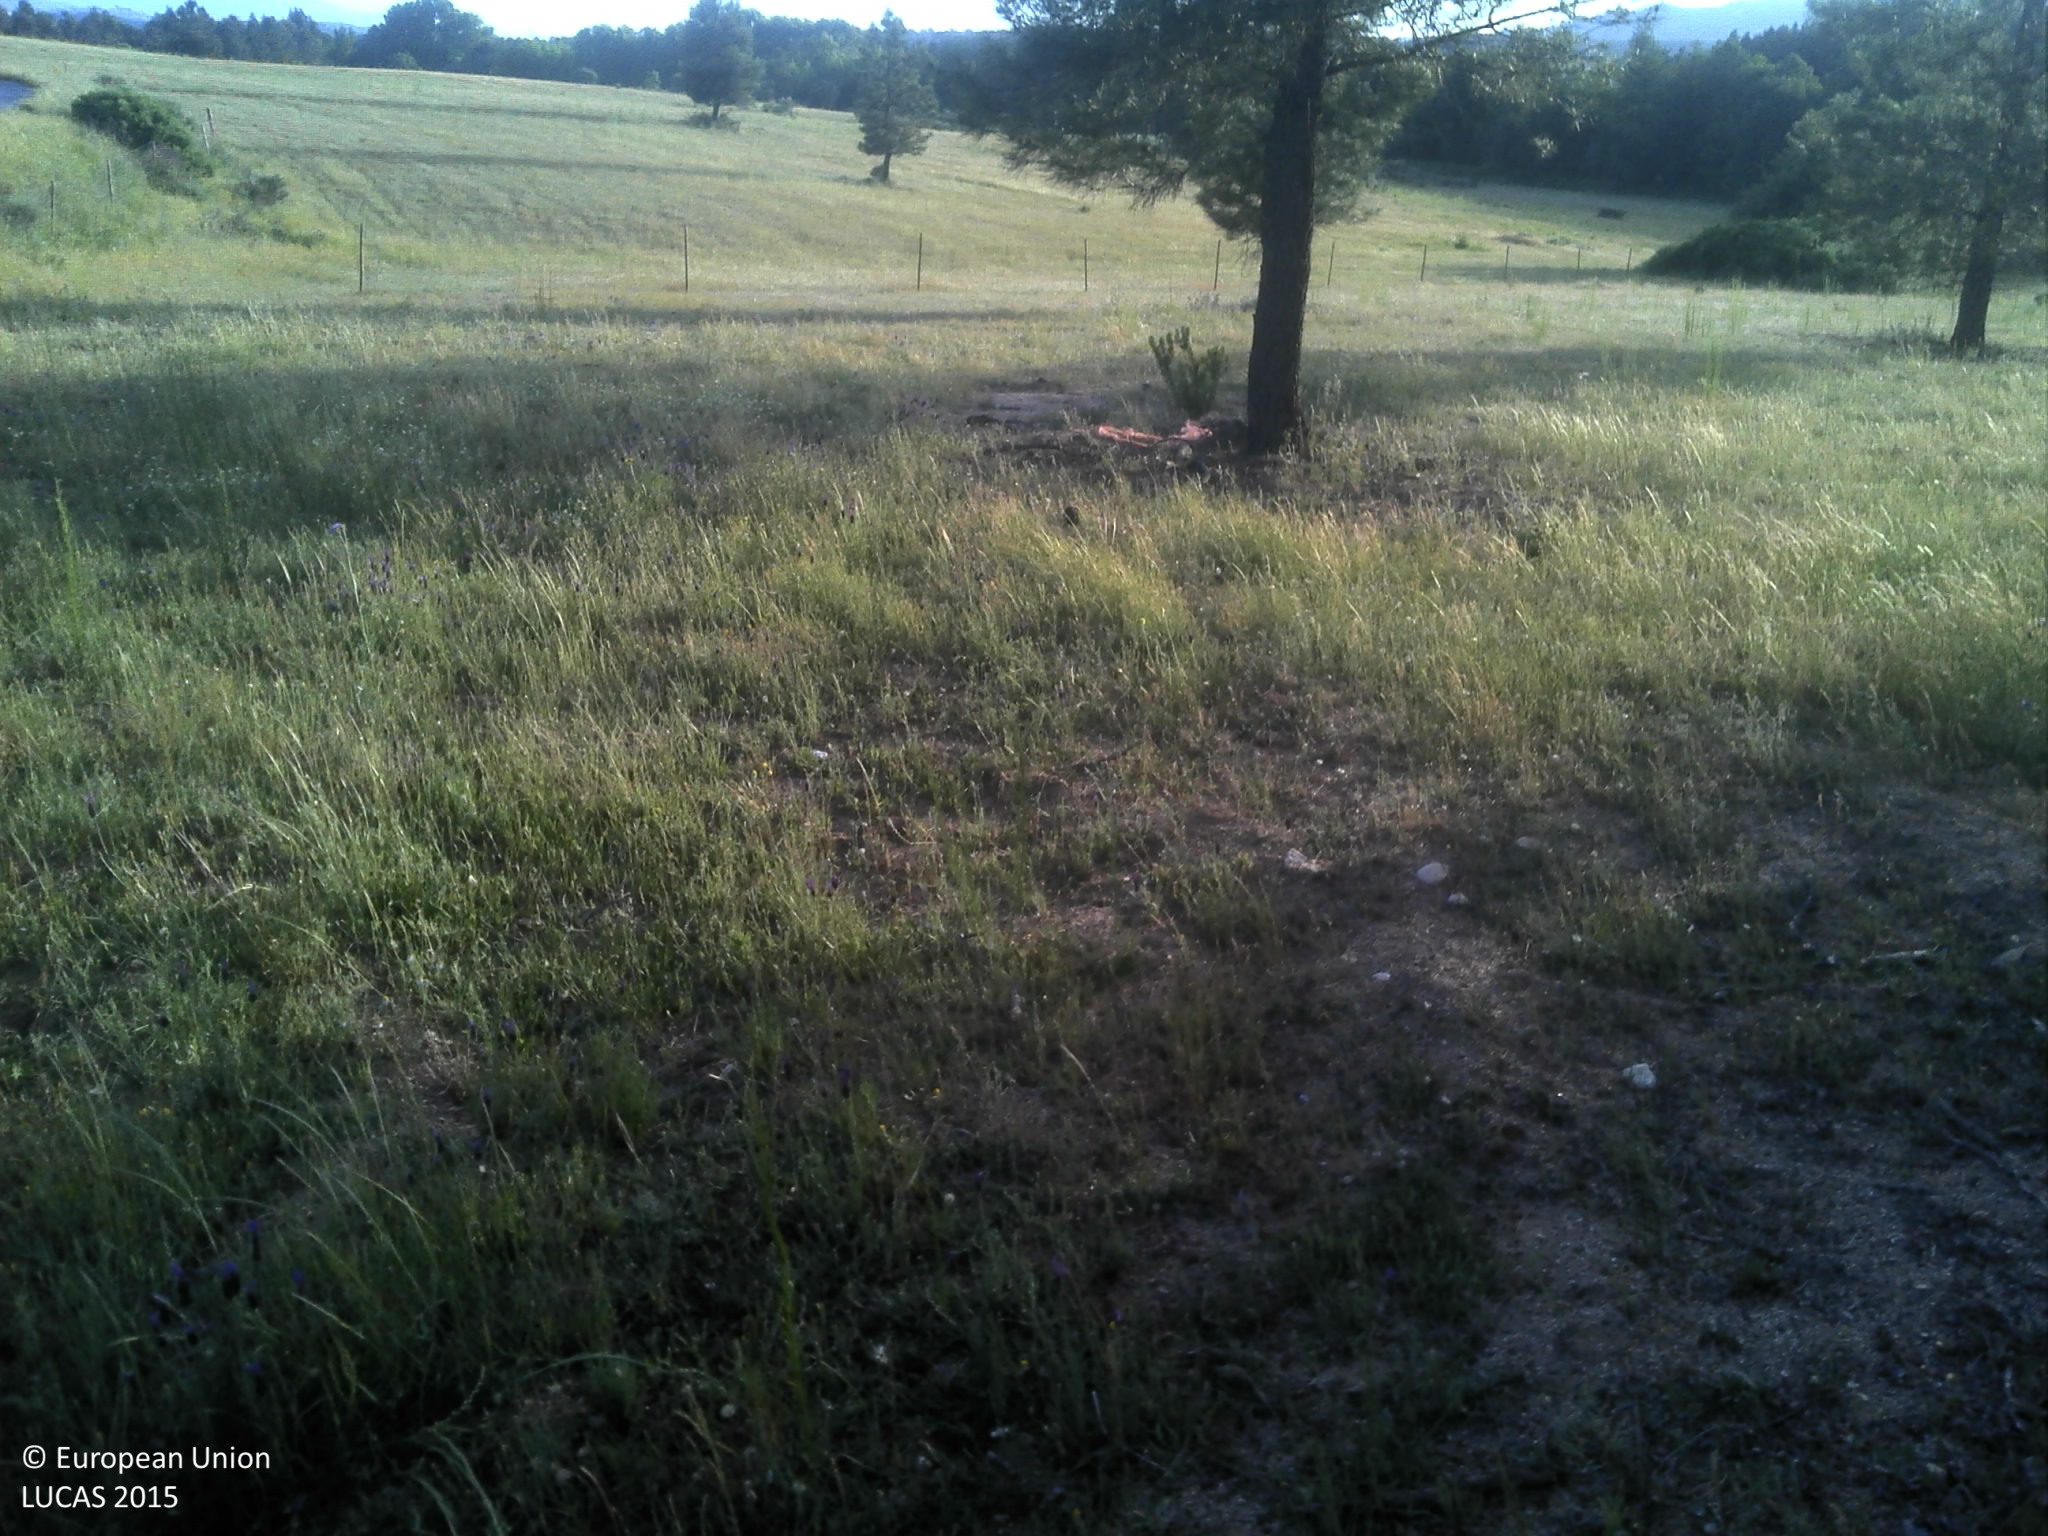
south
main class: Woodland
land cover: Pine dominated coniferous woodland
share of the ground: 10 - 25 %
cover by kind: herbaceous plants 60 %, unconsolidated bare surface 25 %, coniferous forest trees 15 %
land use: Forestry
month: May
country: PT
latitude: 40.7040
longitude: -7.3311
